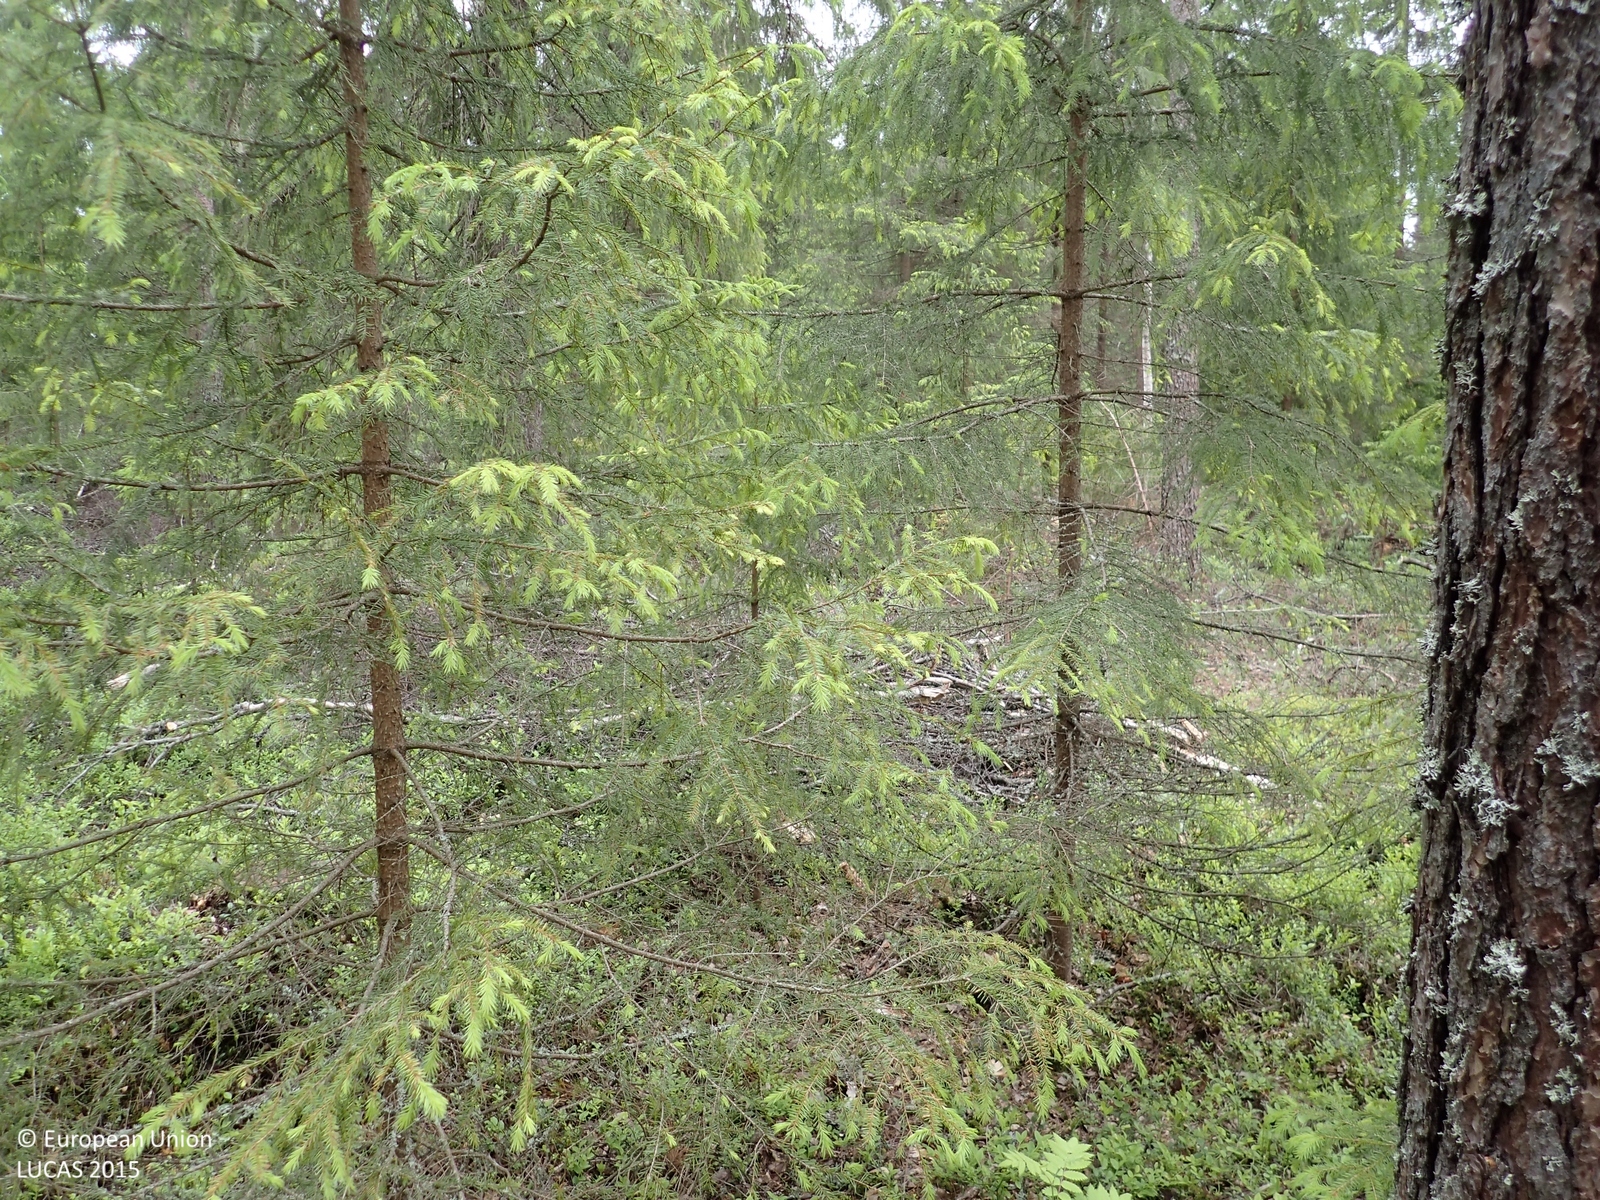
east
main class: Woodland
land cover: Spruce dominated coniferous woodland
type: boreal forest
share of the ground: 25 - 50 %
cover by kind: shrubs 55 %, coniferous forest trees 45 %
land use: Forestry
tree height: > 5 m
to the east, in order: Spruce dominated coniferous woodland; Tracks; Spruce dominated coniferous woodland; Ditches and canals; Shruby margins; Tracks; Shruby margins; Ditches and canals; Spruce dominated coniferous woodland; Tracks; Spruce dominated coniferous woodland; Ditches and canals; Spruce dominated mixed woodland; Broadleaved woodland; Pine dominated mixed woodland; Broadleaved woodland; Spruce dominated mixed woodland; Ditches and canals; Spruce dominated mixed woodland; Broadleaved woodland; Pine dominated coniferous woodland
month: June
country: FI
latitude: 62.3735
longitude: 21.7030
